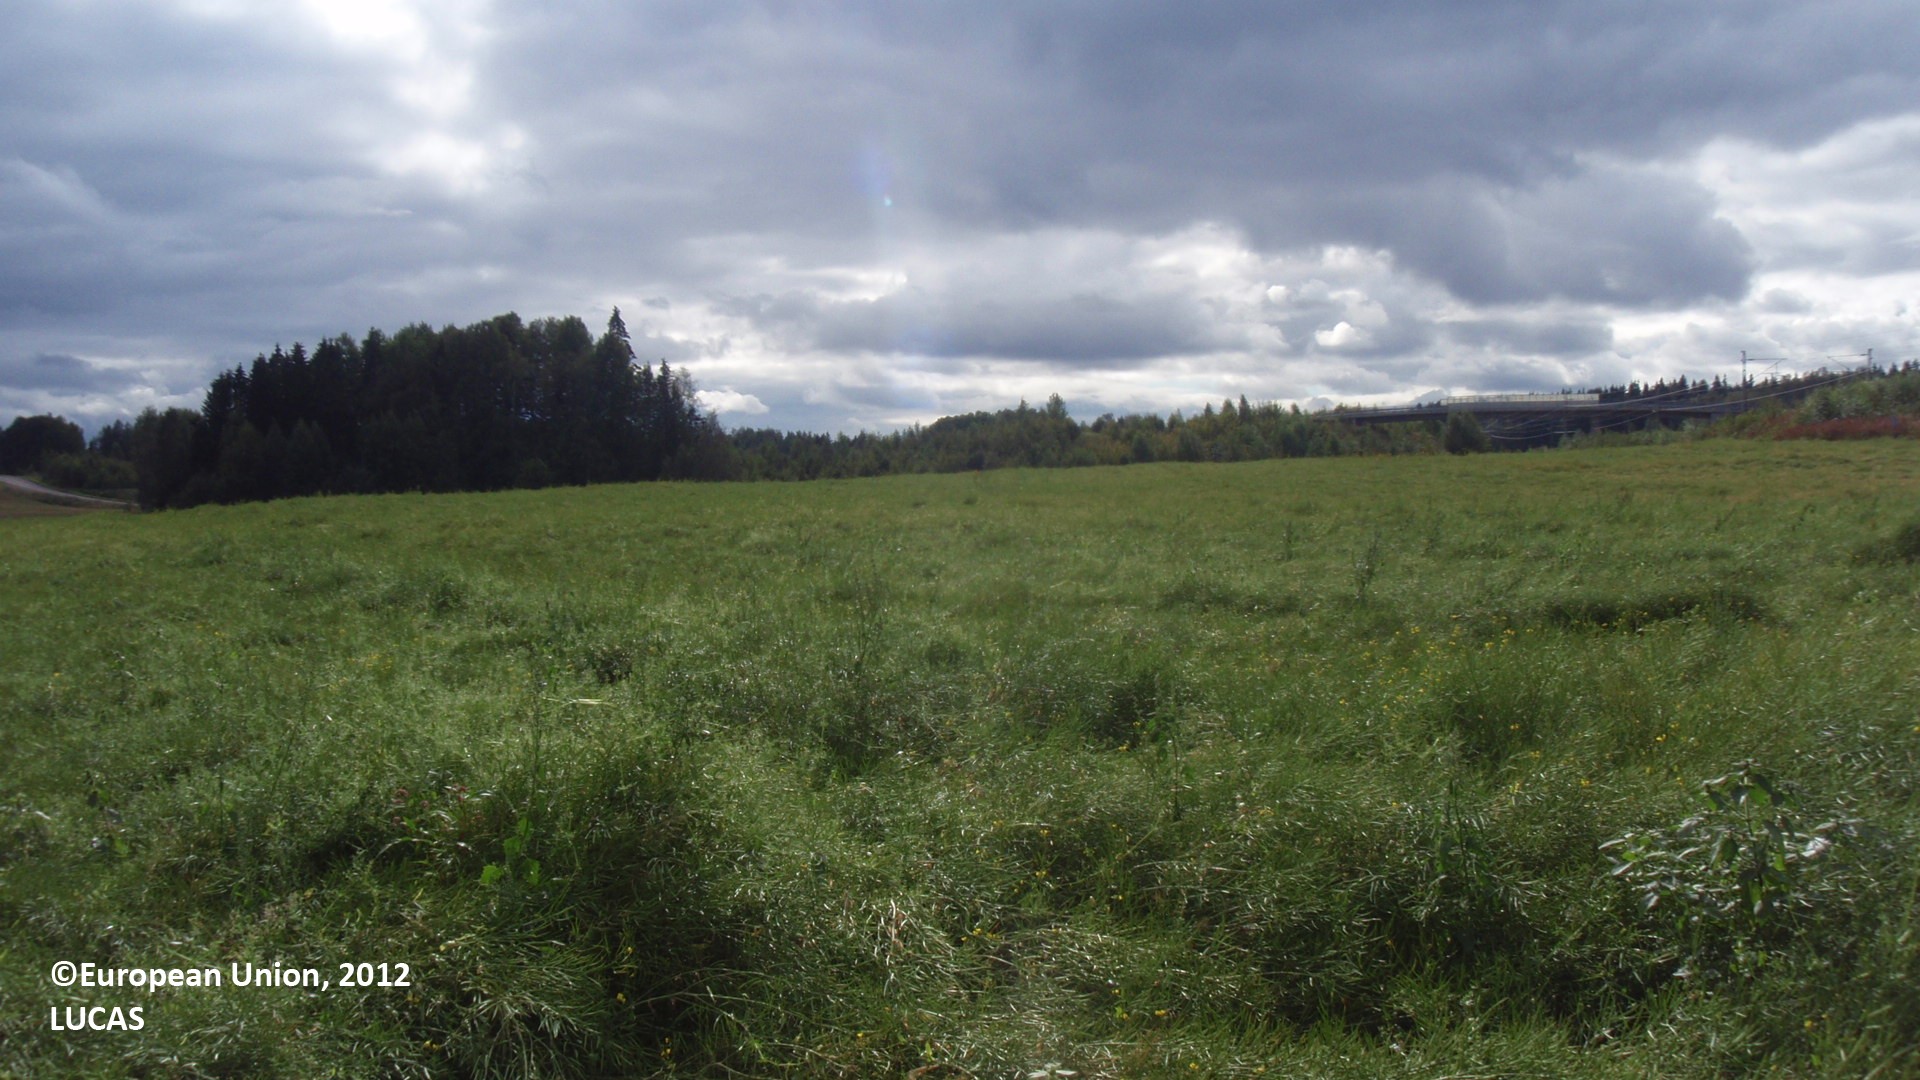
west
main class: Cropland
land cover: Rape and turnip rape
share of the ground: > 75 %
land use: Agriculture (excluding fallow land and kitchen gardens)
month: August
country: FI
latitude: 60.9110
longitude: 27.6119
